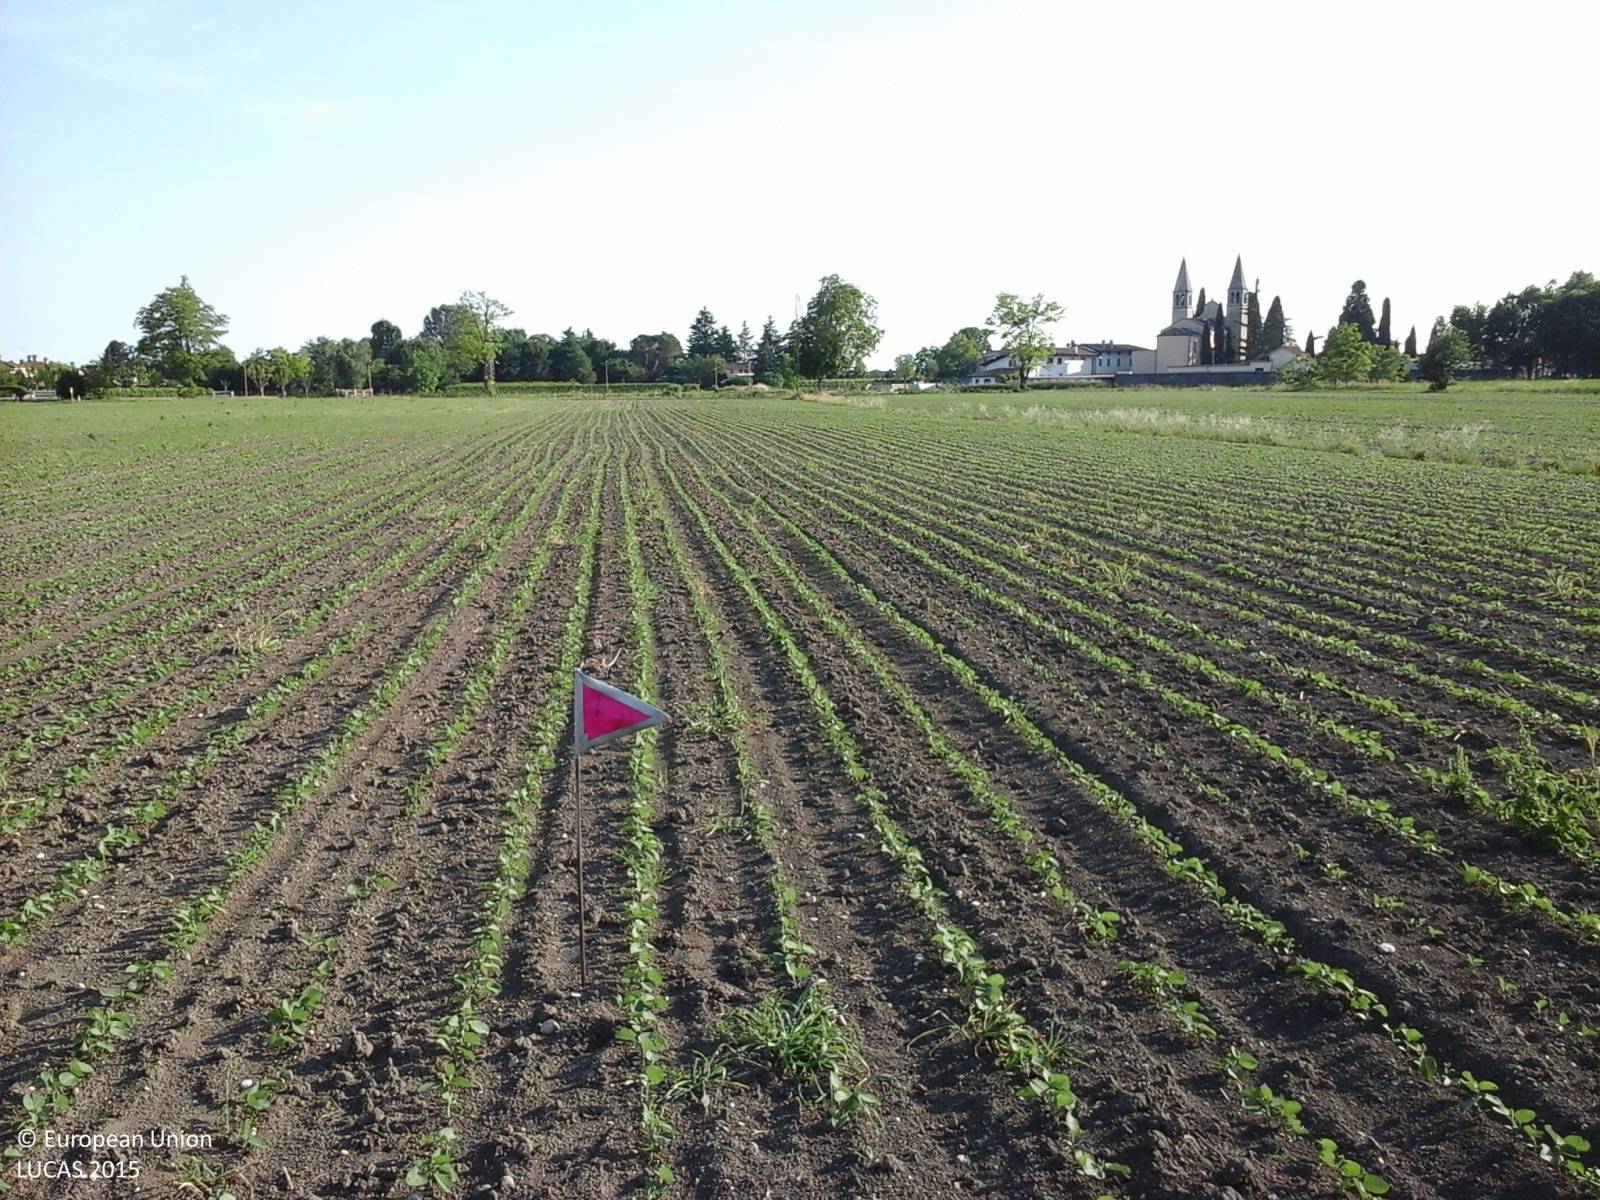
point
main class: Cropland
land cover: Soya
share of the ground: 25 - 50 %
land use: Agriculture (excluding fallow land and kitchen gardens)
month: June
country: IT
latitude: 45.8494
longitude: 13.3056
